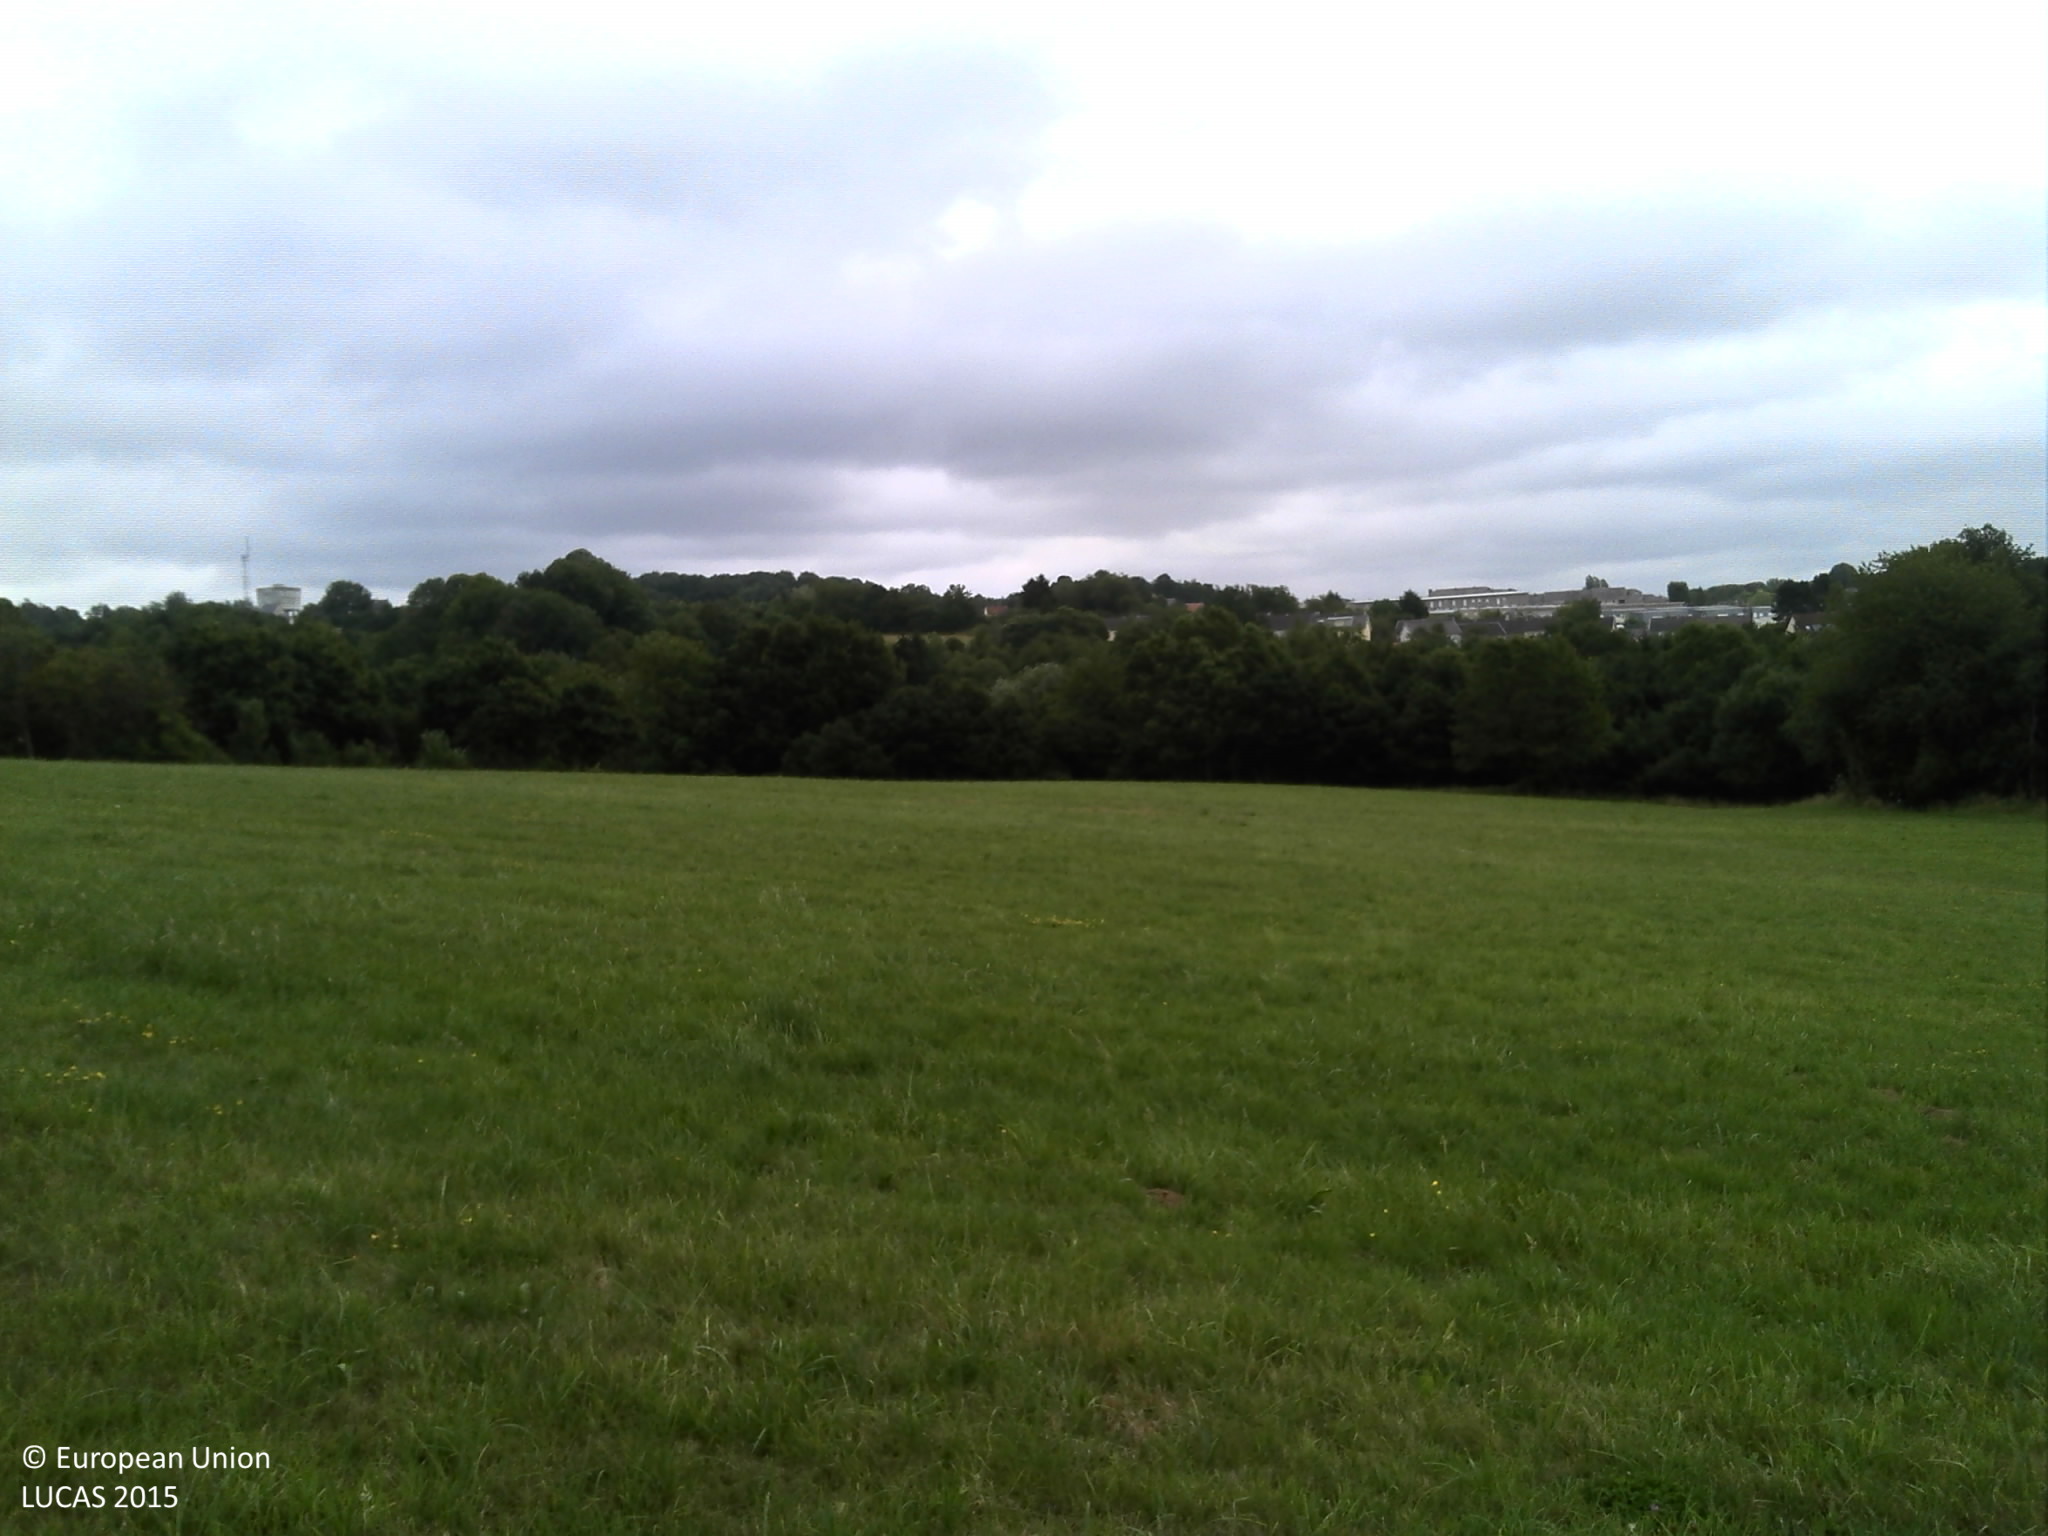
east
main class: Grassland
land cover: Grassland without tree/shrub cover
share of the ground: > 75 %
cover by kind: herbaceous plants 100 %
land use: Agriculture (excluding fallow land and kitchen gardens)
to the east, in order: Grassland without tree/shrub cover; Broadleaved woodland; Fences; Broadleaved woodland; Ditches and canals; Shrubland with sparse tree cover
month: July
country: FR
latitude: 49.7909
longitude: 4.7043
